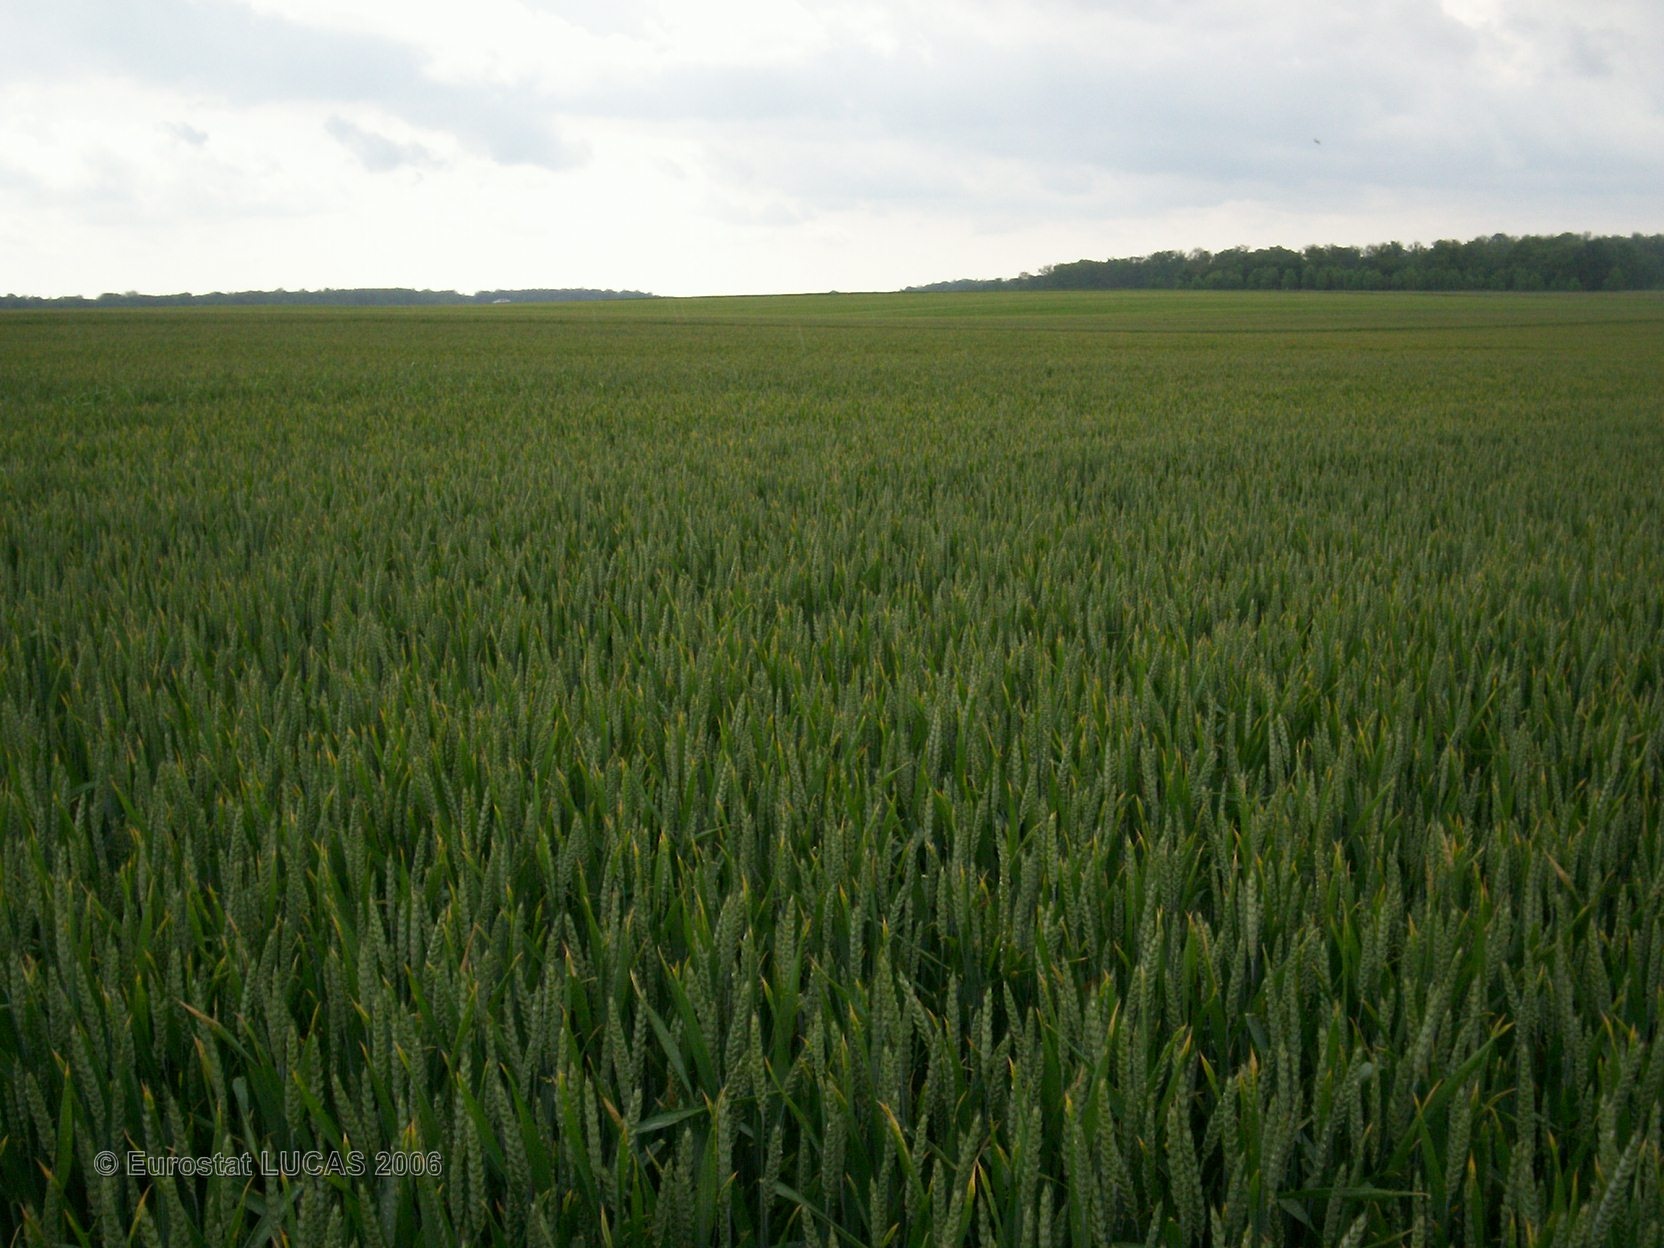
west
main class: Cropland
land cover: Common wheat
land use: Agriculture (excluding fallow land and kitchen gardens)
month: June
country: FR
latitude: 48.5623
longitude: 4.6451
